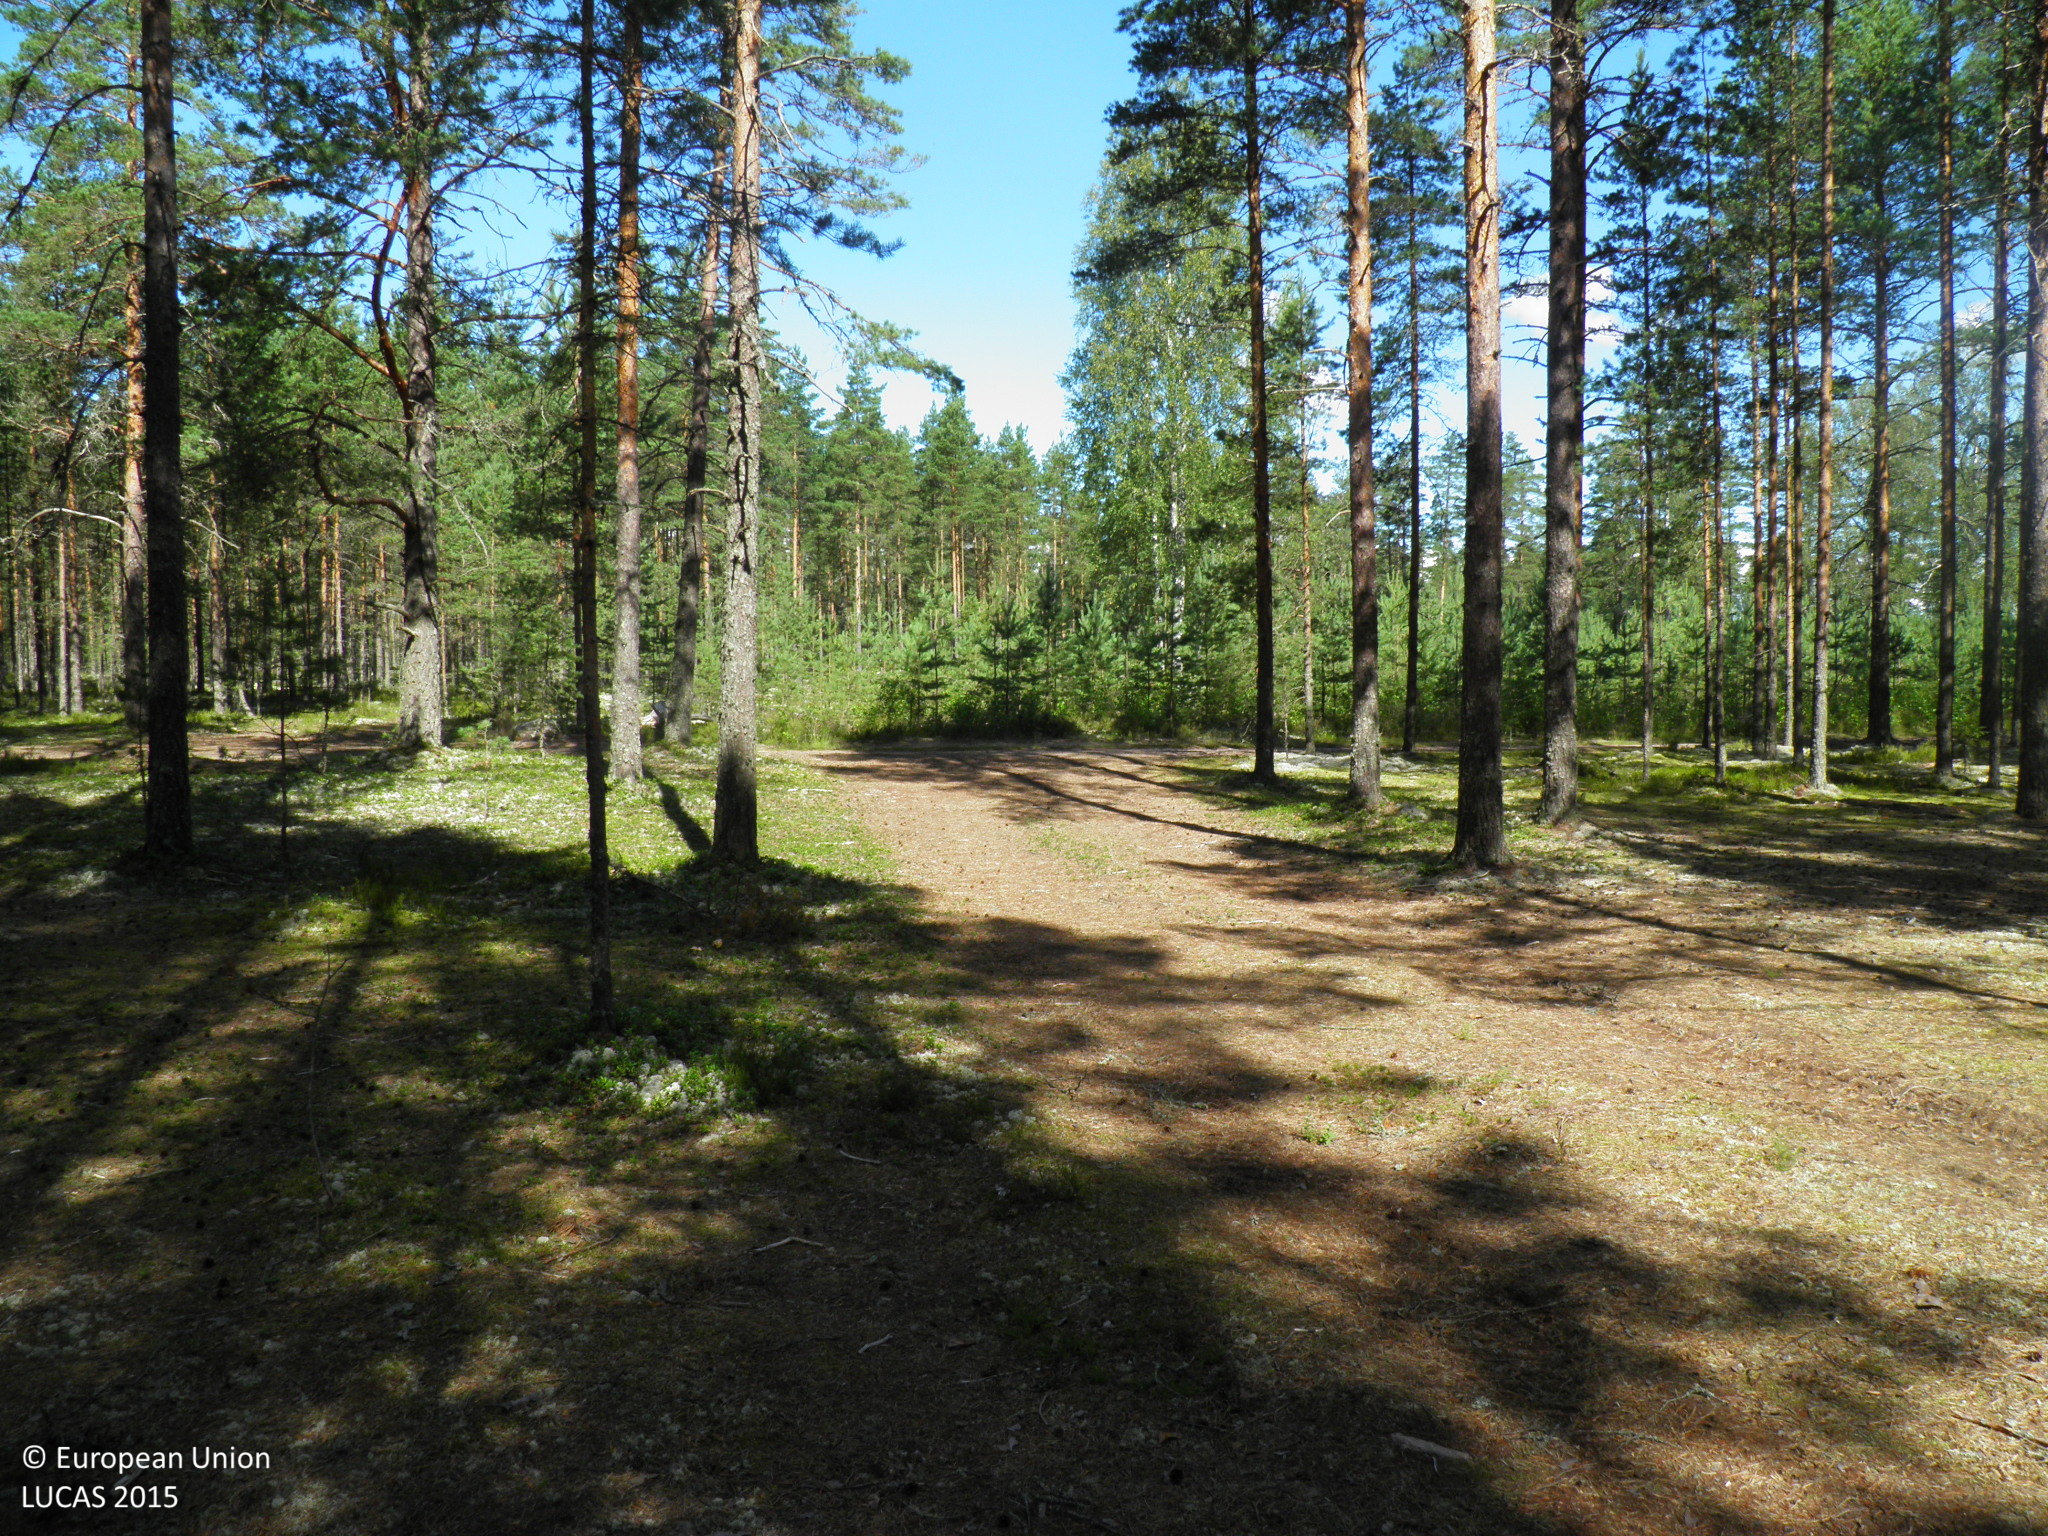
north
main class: Woodland
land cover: Pine dominated coniferous woodland
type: hemiboreal forest and nemoral coniferous forest and mixed broadleaved-coniferous forest
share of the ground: 50 - 75 %
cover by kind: coniferous forest trees 50 %, lichens and mosses 25 %, unconsolidated bare surface 25 %
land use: Forestry
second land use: Amenities, museums, leisure
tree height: > 5 m
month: August
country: FI
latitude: 60.9881
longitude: 22.5443
